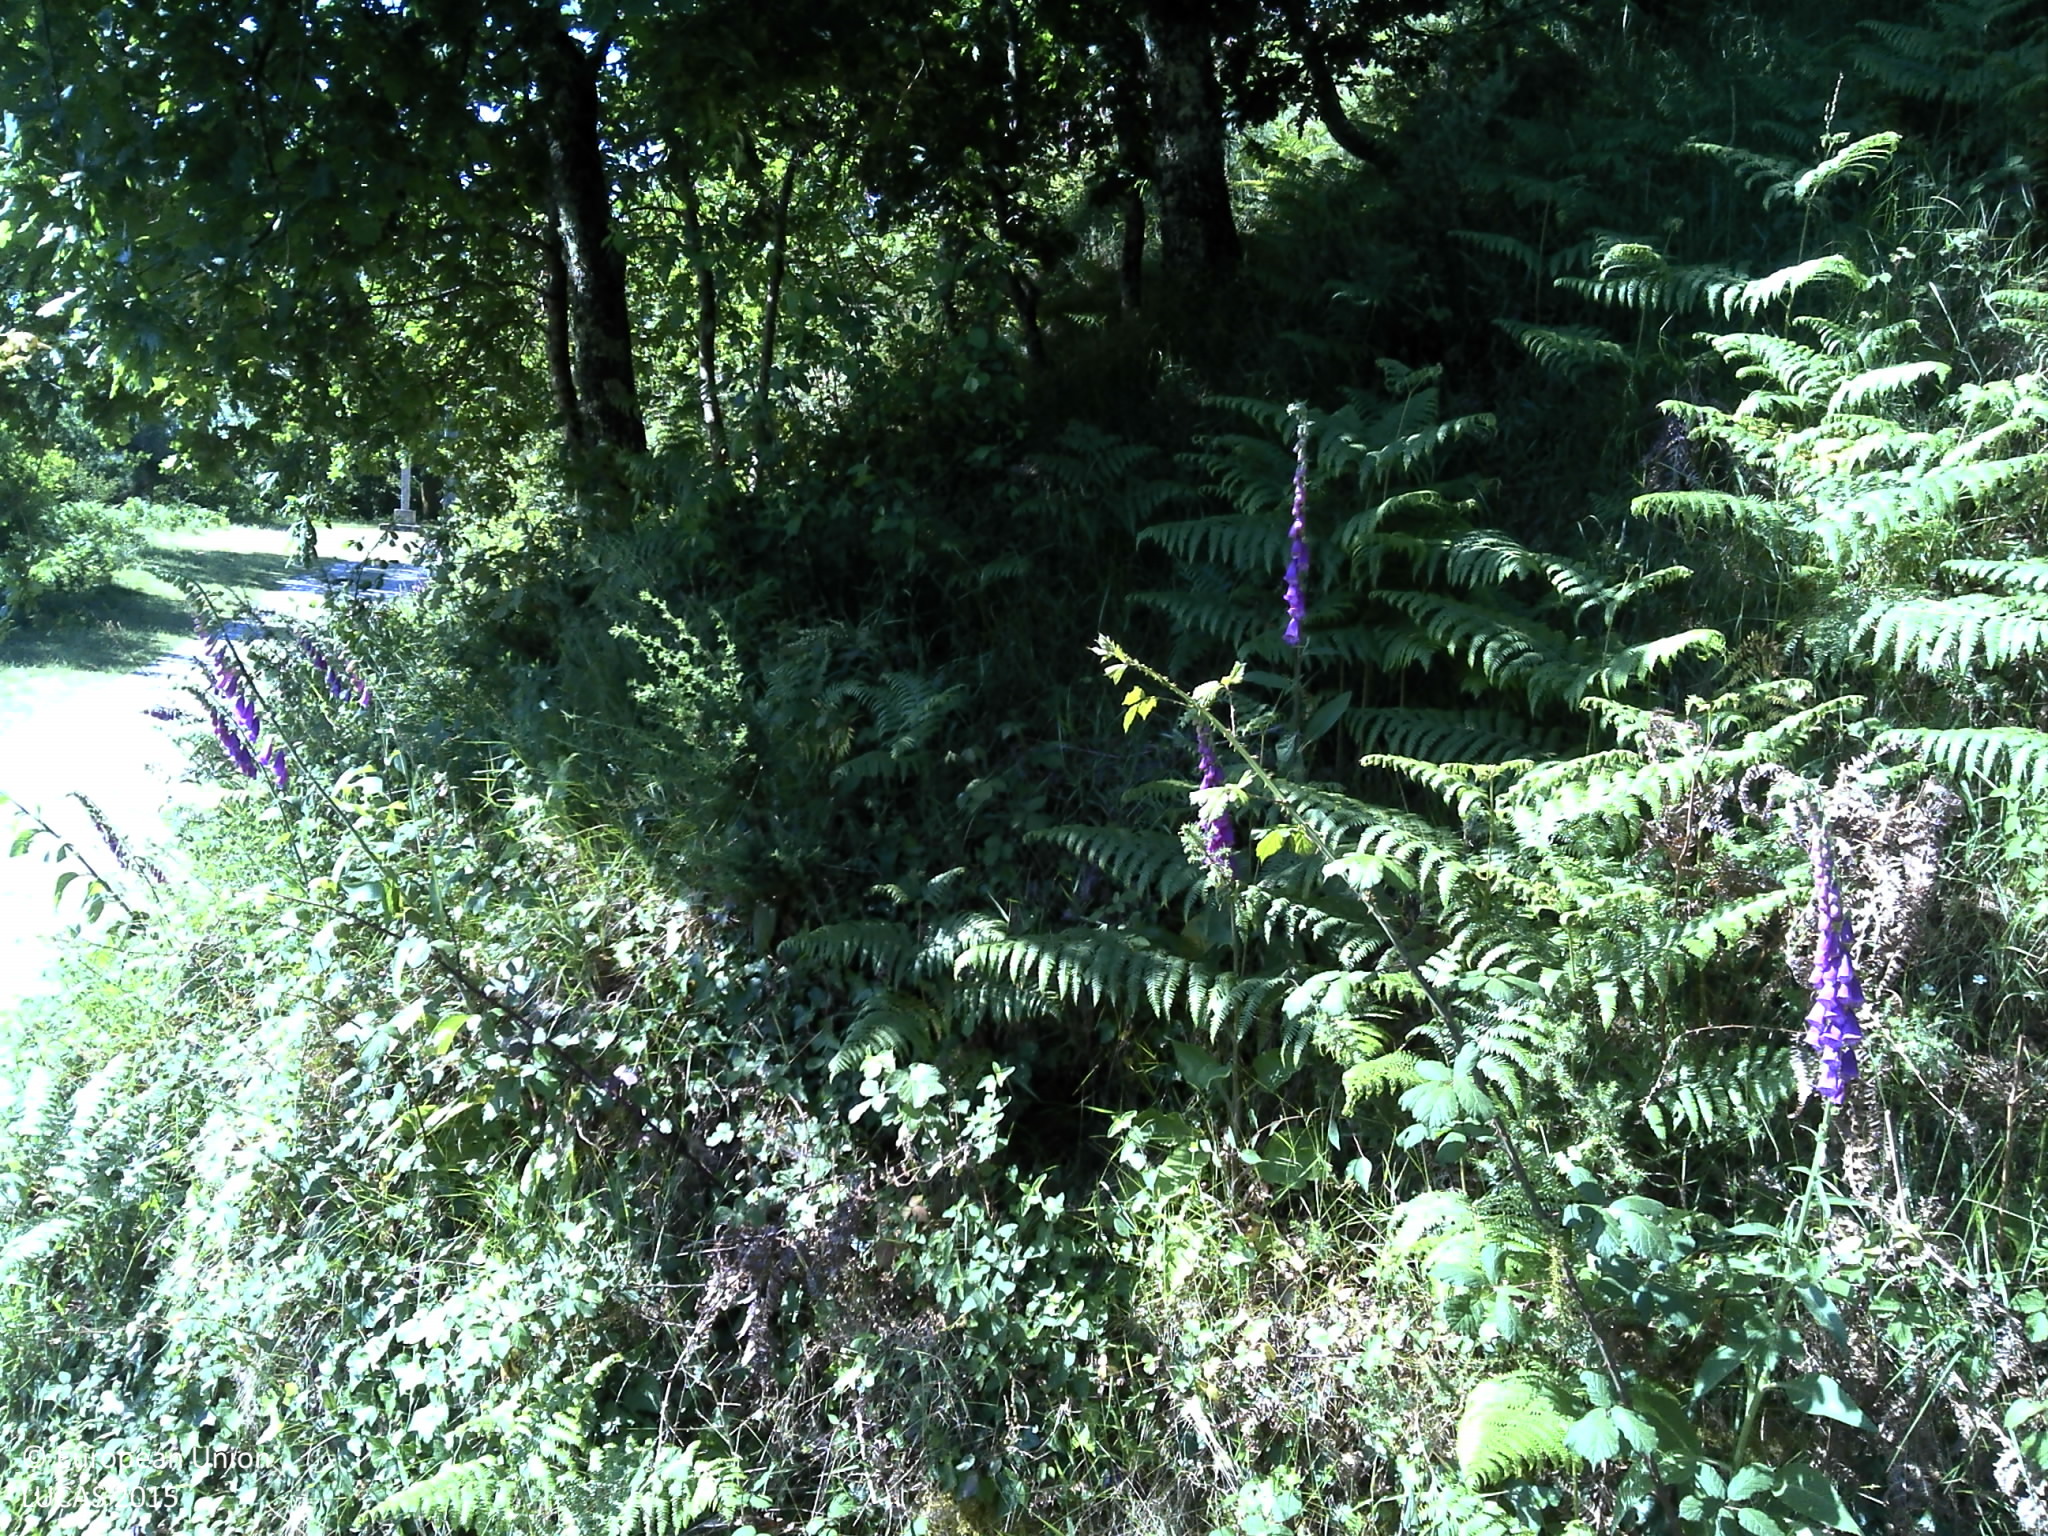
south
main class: Shrubland
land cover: Shrubland with sparse tree cover
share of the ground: 50 - 75 %
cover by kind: shrubs 60 %, unconsolidated bare surface 20 %, herbaceous plants 15 %, broadleaved forest trees 5 %
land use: Semi-natural and natural areas not in use
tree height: > 5 m
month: May
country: PT
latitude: 41.9112
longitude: -8.6982
